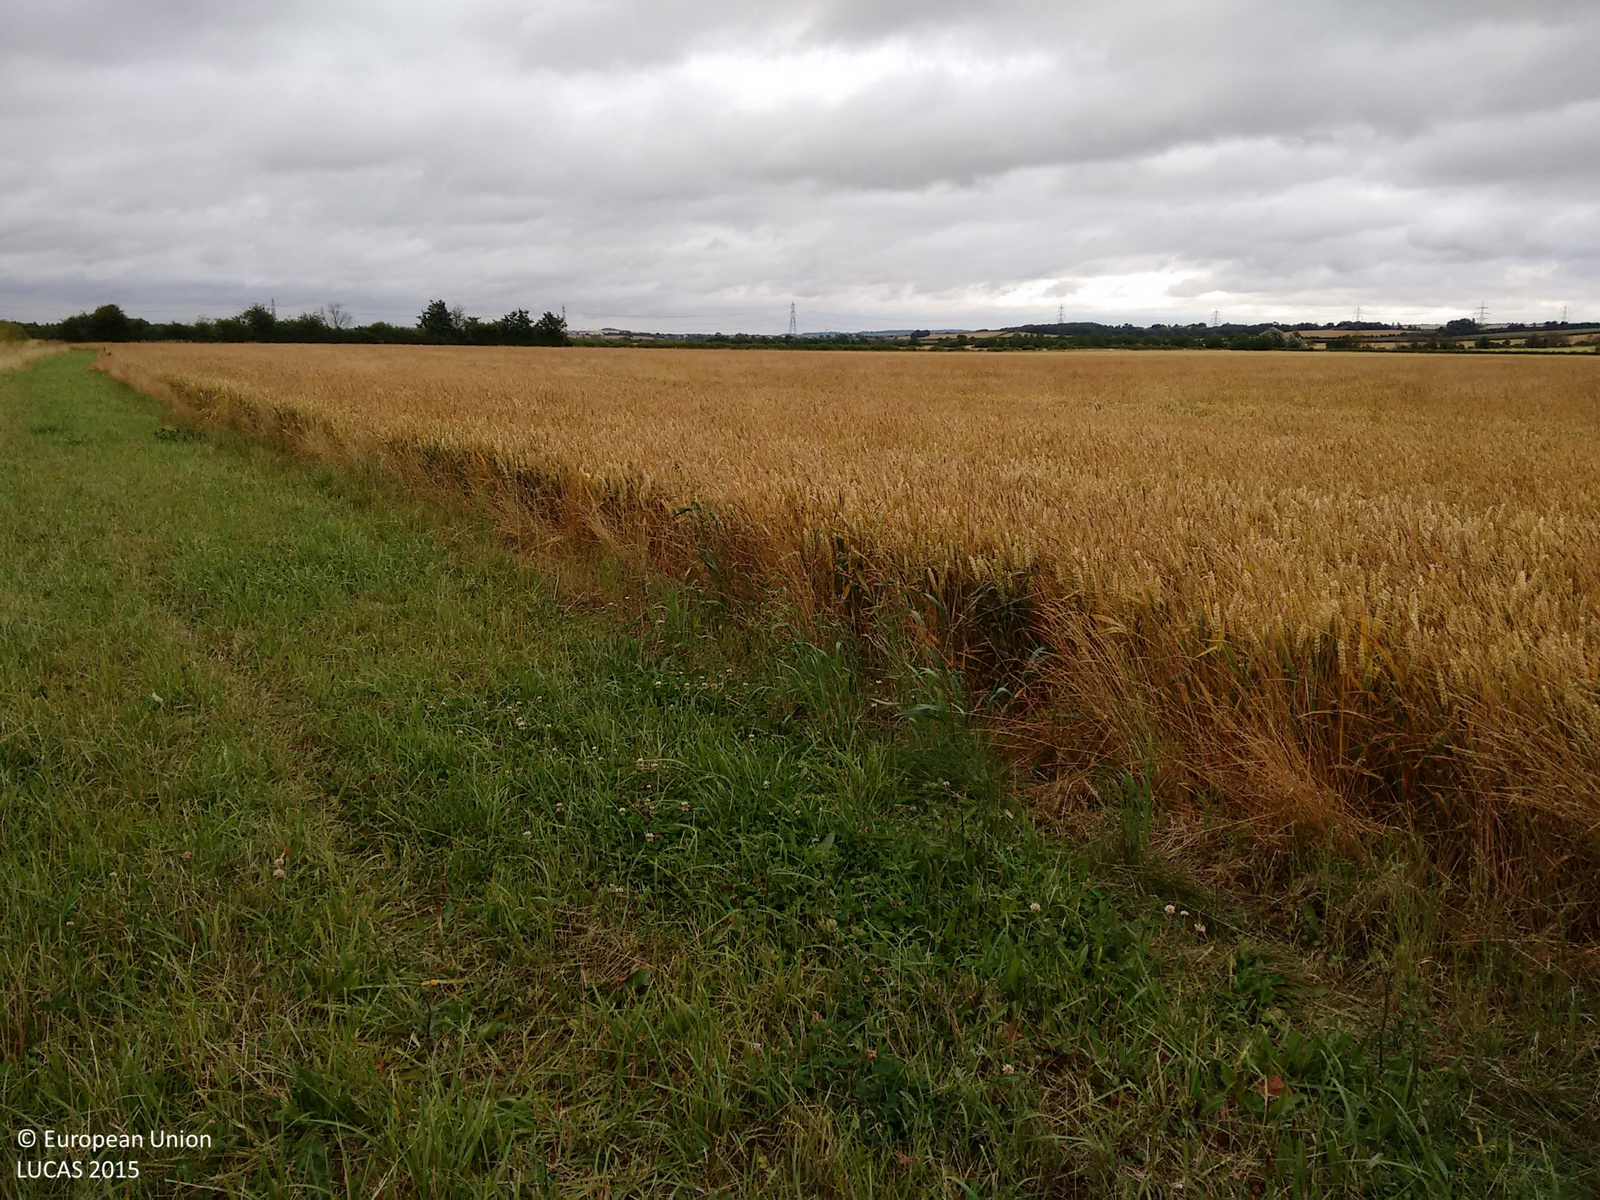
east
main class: Grassland
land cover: Grassland without tree/shrub cover
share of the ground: > 75 %
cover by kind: herbaceous plants 100 %
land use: Agriculture (excluding fallow land and kitchen gardens)
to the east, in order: Managed hedges; Grassland without tree/shrub cover; Common wheat
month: July
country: GB
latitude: 52.9561
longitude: -0.7735
